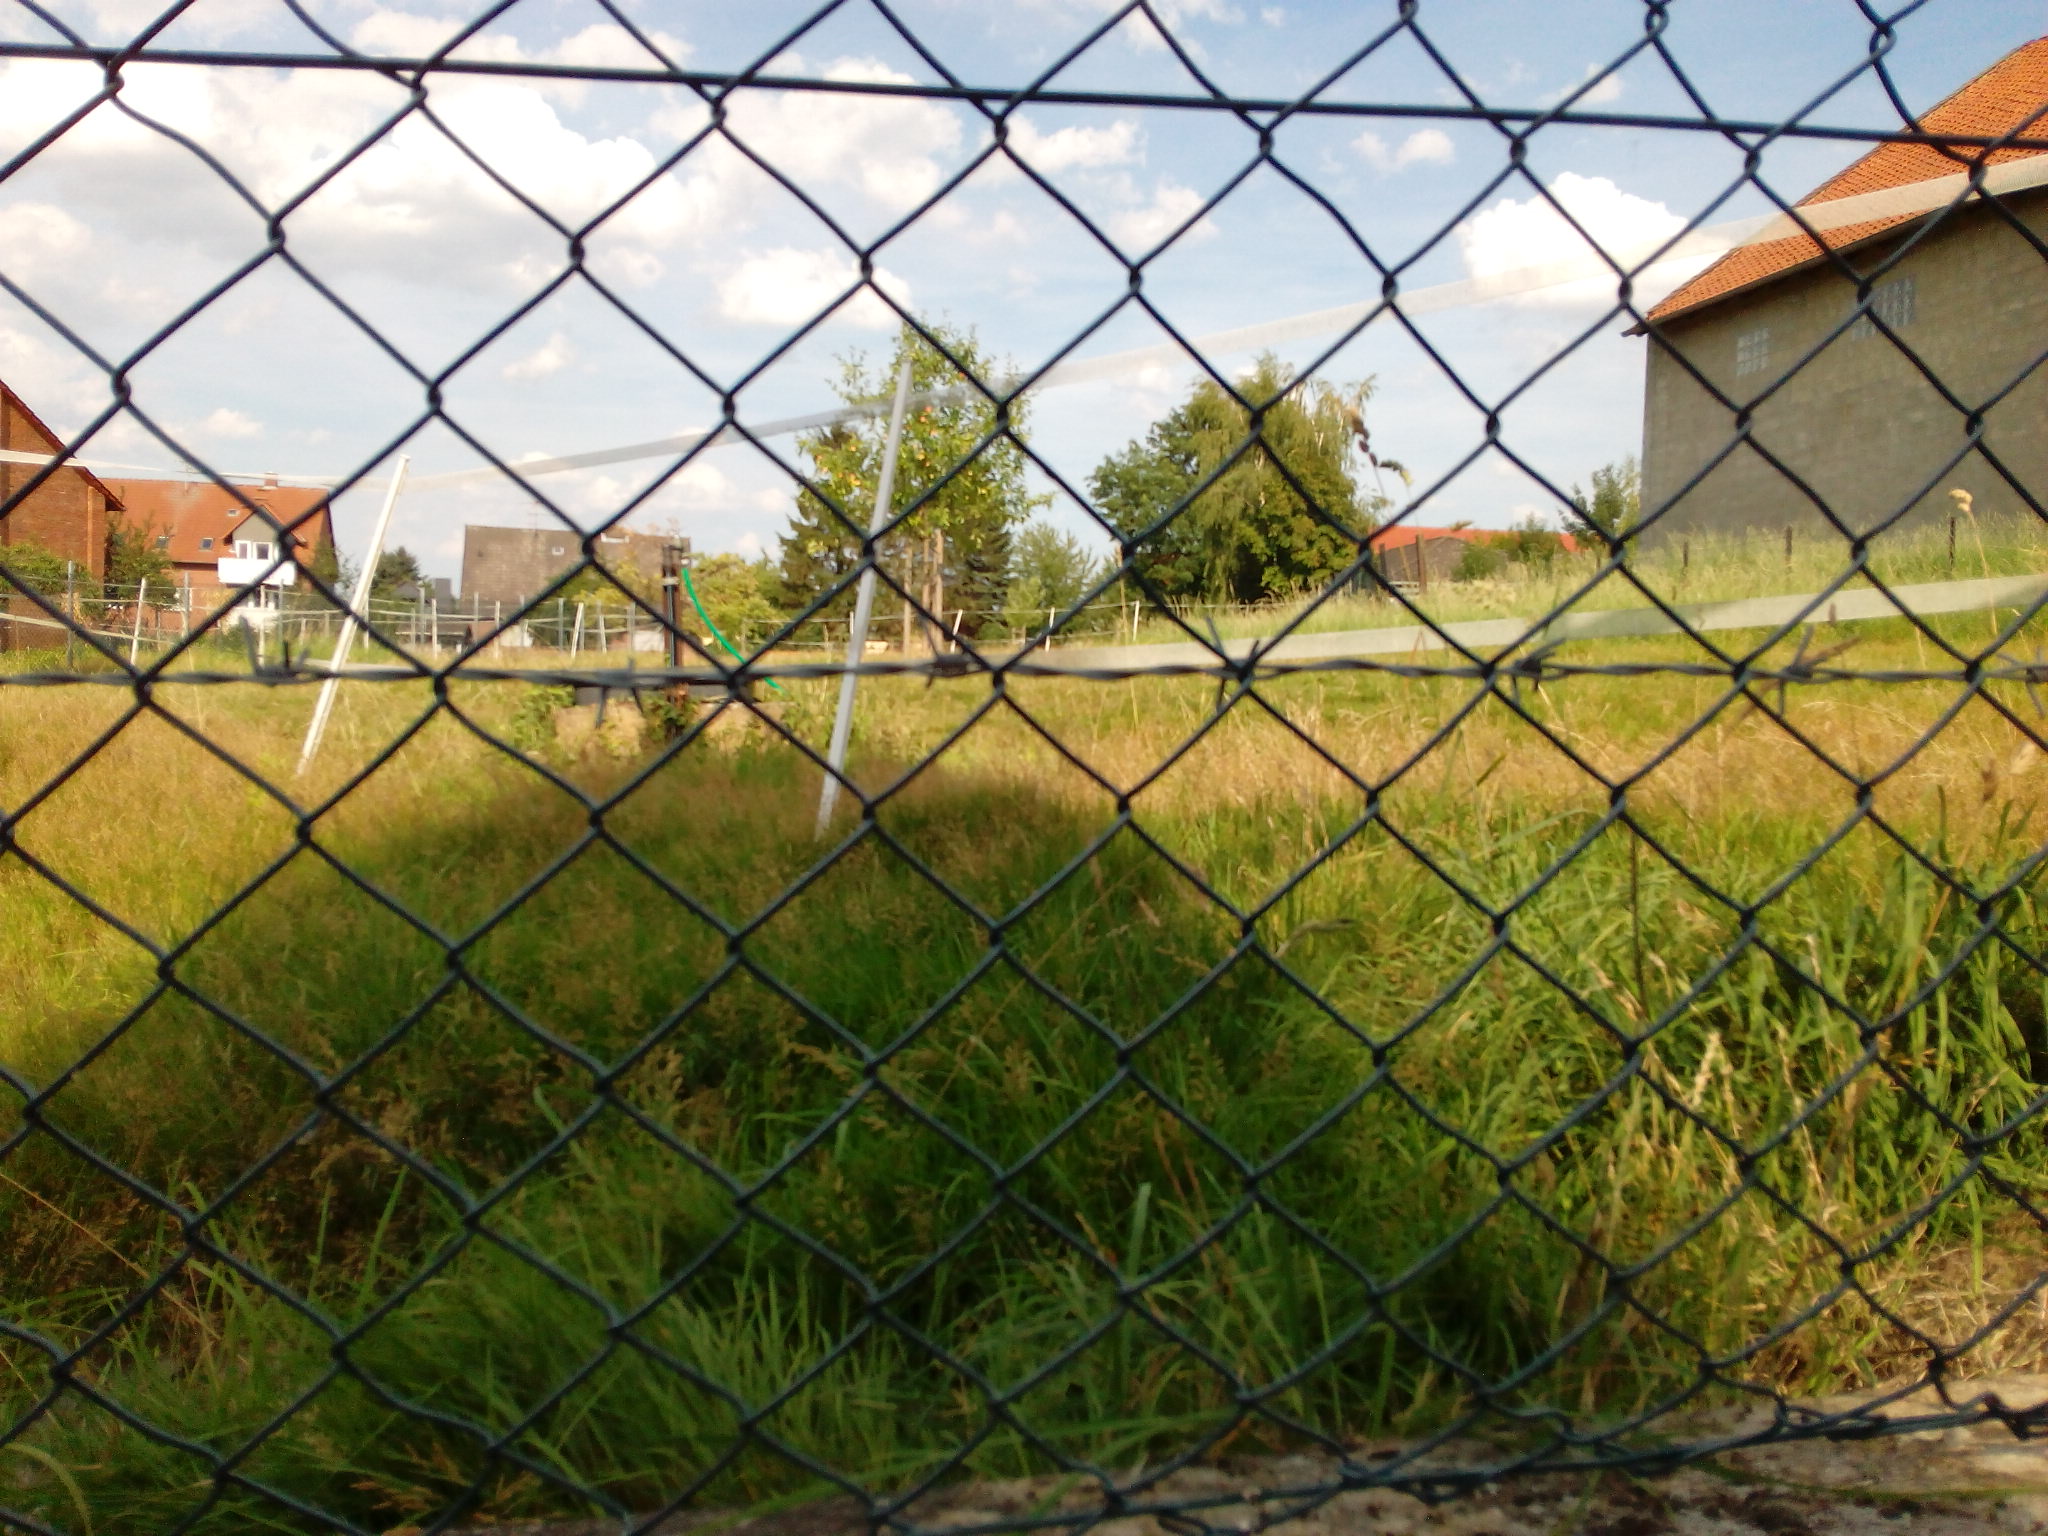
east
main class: Grassland
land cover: Grassland with sparse tree/shrub cover
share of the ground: > 75 %
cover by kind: herbaceous plants 95 %, broadleaved forest trees 5 %
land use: Agriculture (excluding fallow land and kitchen gardens)
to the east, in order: Grassland with sparse tree/shrub cover; Fences; Grassland without tree/shrub cover; Artificial constructions in urban areas
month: August
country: DE
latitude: 52.1977
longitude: 9.8976
